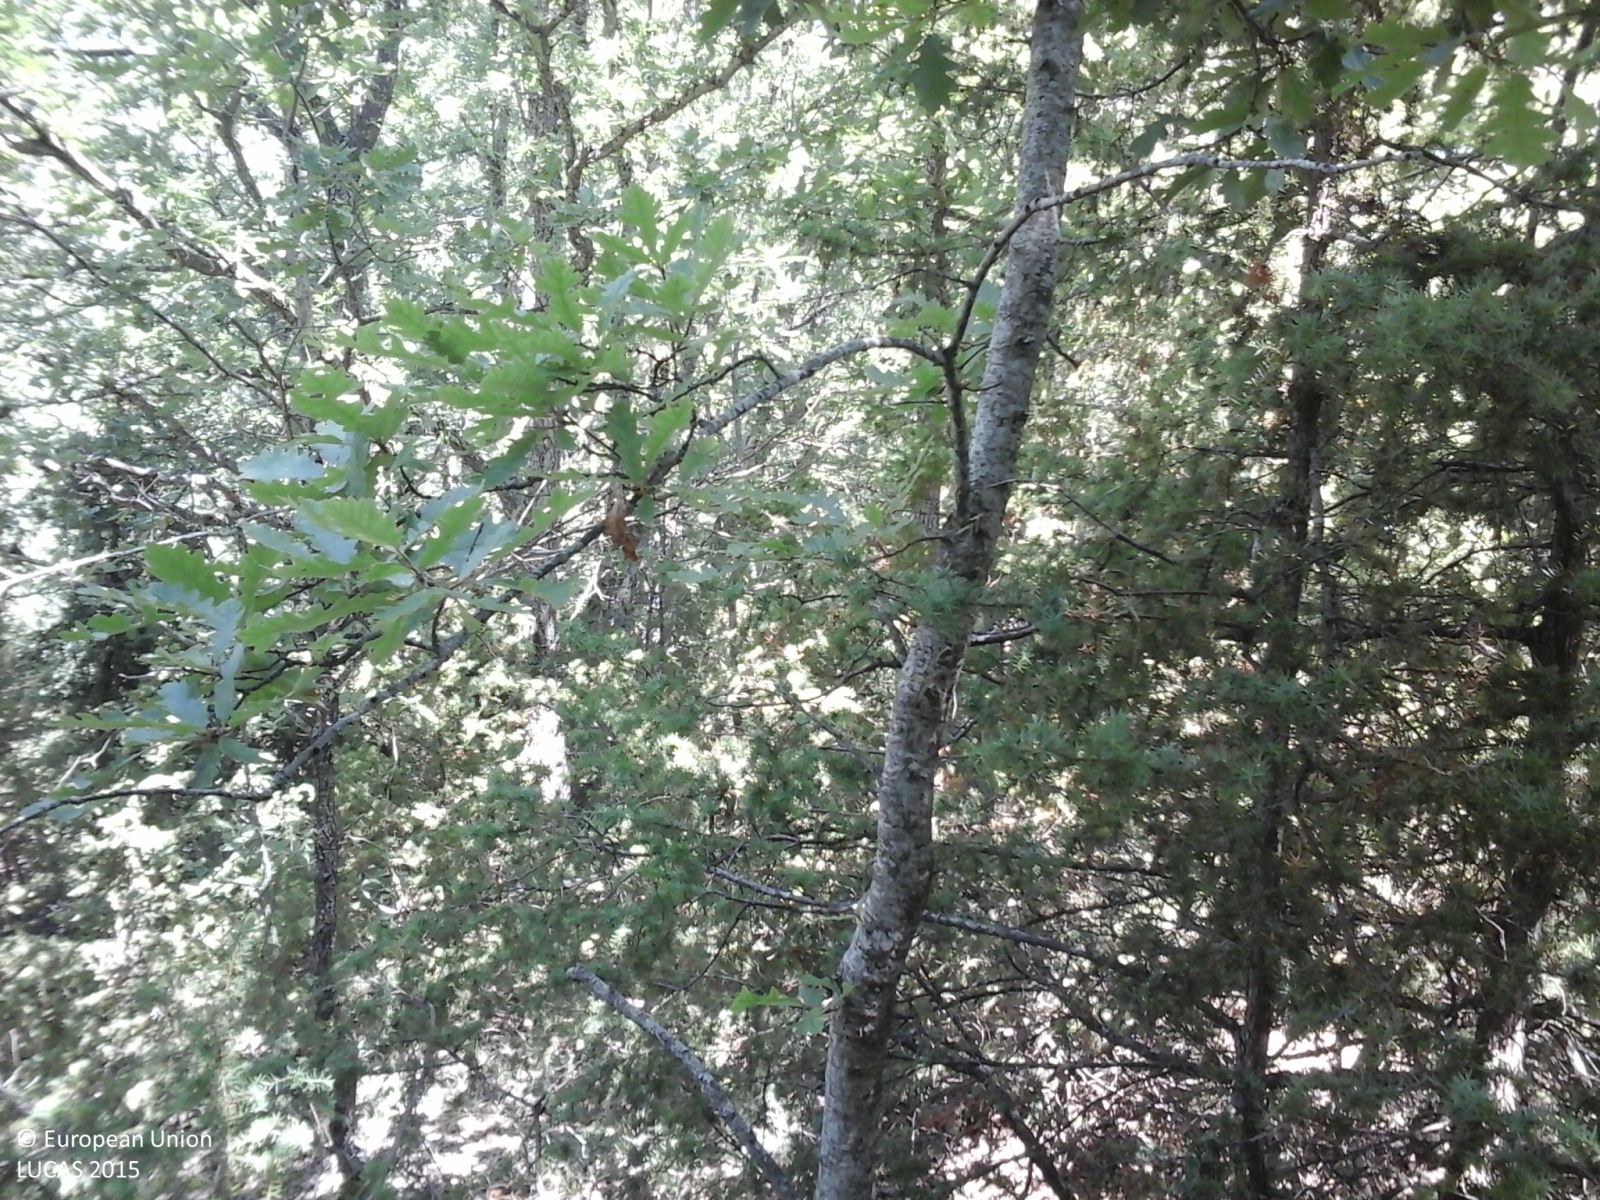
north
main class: Woodland
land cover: Broadleaved woodland
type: thermophilous deciduous forest
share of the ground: > 75 %
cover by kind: broadleaved forest trees 100 %
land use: Forestry
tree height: > 5 m
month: June
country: IT
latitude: 42.7284
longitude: 13.2512
